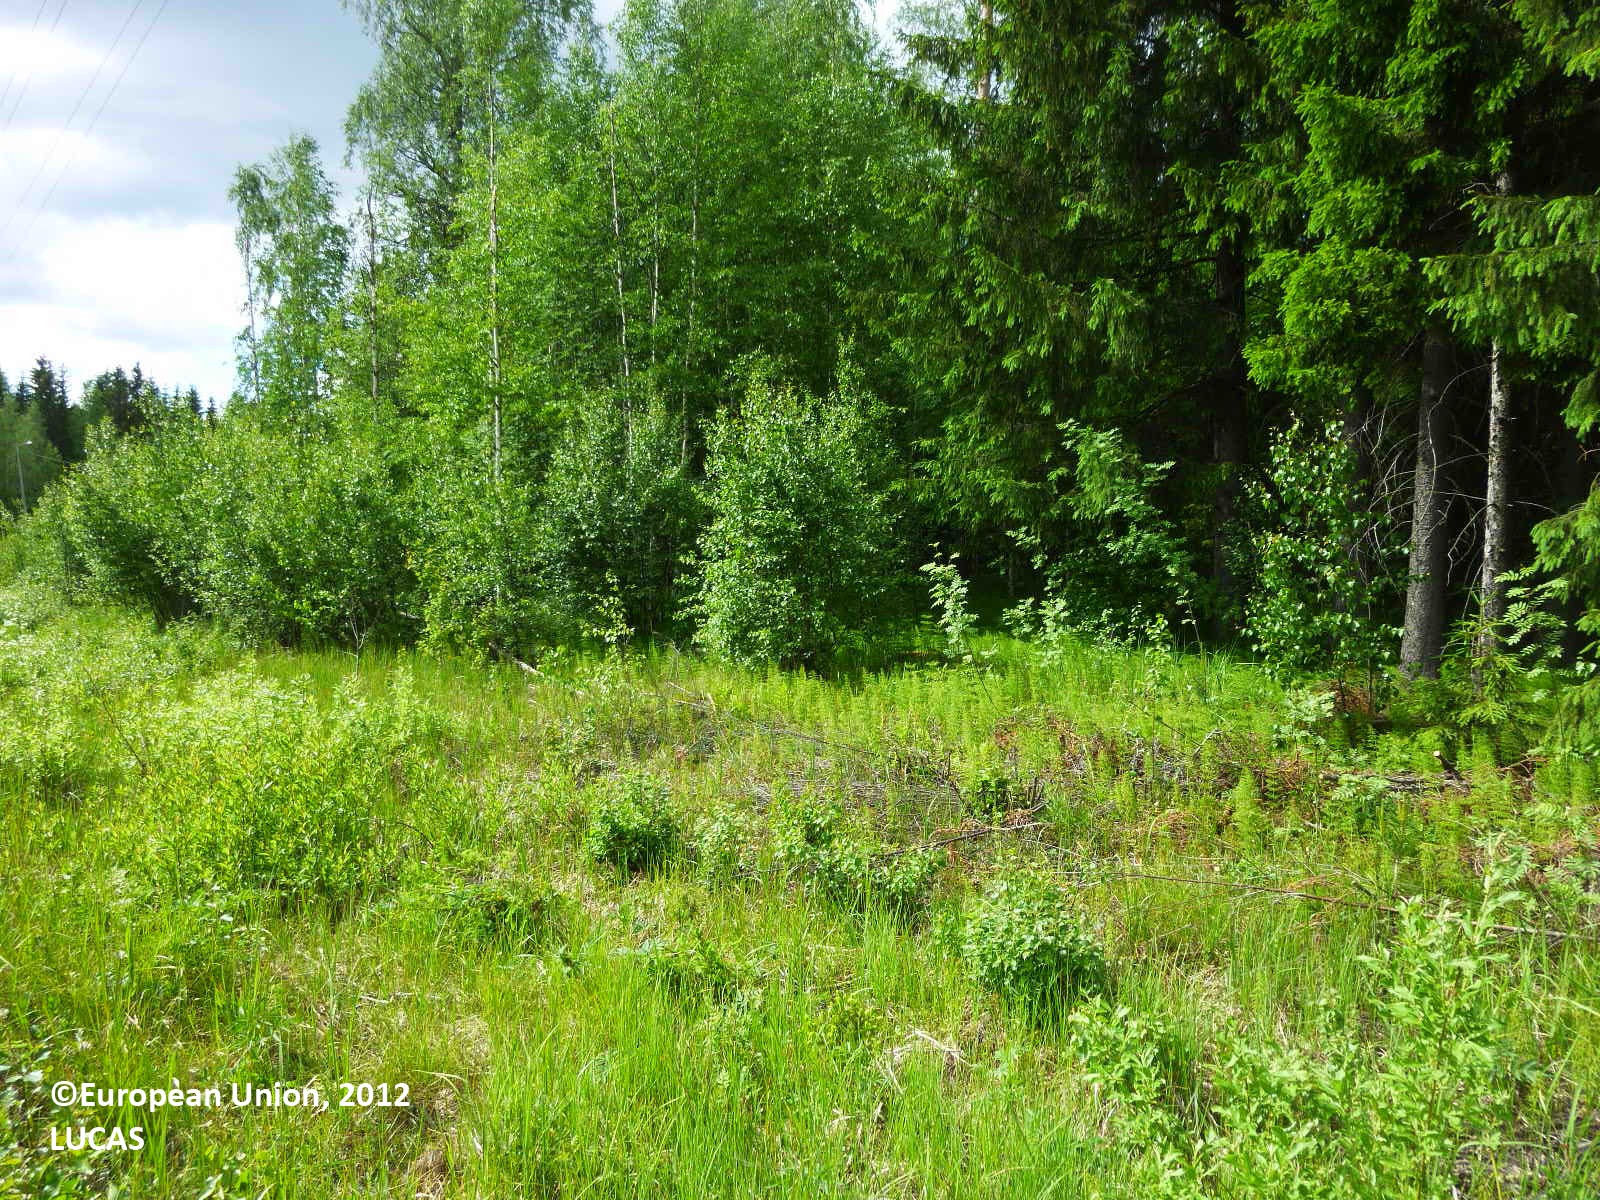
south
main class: Grassland
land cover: Grassland without tree/shrub cover
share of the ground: > 75 %
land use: Road transport
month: June
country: FI
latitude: 61.4780
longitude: 22.5868
